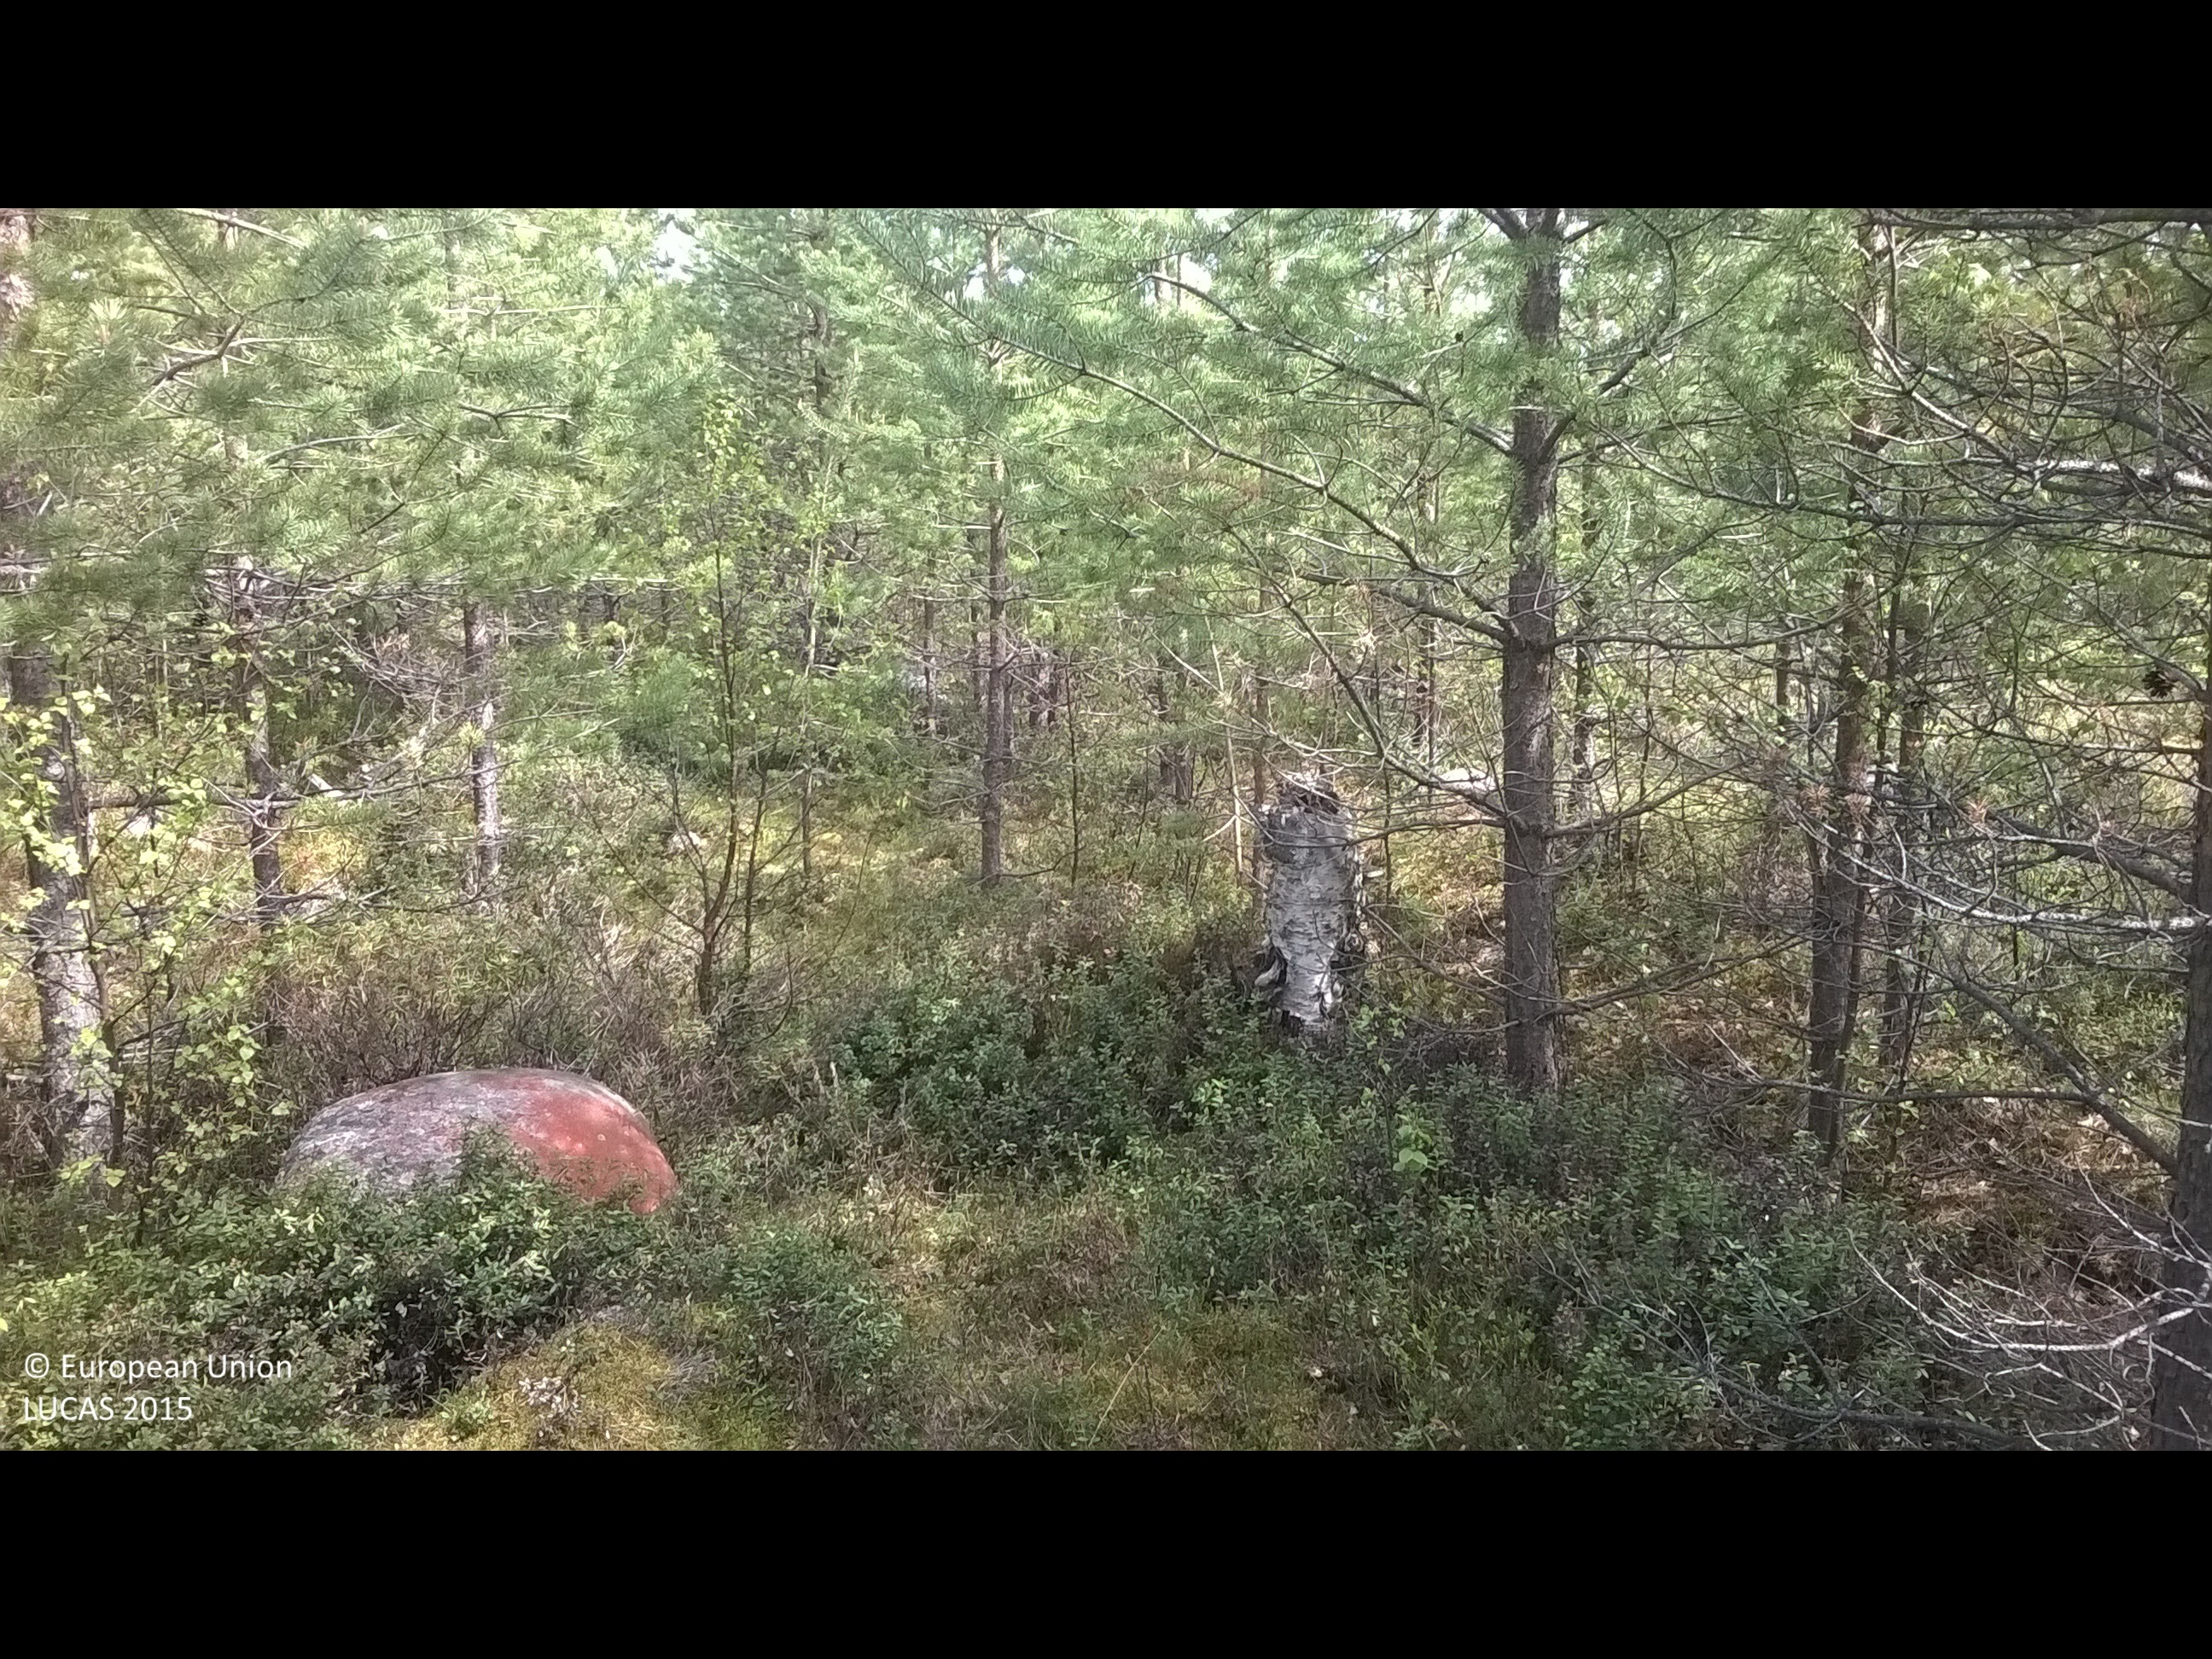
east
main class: Woodland
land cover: Pine dominated coniferous woodland
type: boreal forest
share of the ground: > 75 %
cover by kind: coniferous forest trees 90 %, broadleaved forest trees 5 %, shrubs 5 %
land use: Forestry
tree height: < 5 m
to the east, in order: Pine dominated coniferous woodland; Ditches and canals; Pine dominated coniferous woodland; Ditches and canals; Pine dominated coniferous woodland; Tracks; Pine dominated coniferous woodland; Ditches and canals; Pine dominated coniferous woodland; Ditches and canals; Pine dominated coniferous woodland; Pine dominated mixed woodland; Ditches and canals; Pine dominated mixed woodland; Ditches and canals; Pine dominated mixed woodland; Tracks; Pine dominated mixed woodland; Ditches and canals; Pine dominated mixed woodland; Ditches and canals; Pine dominated mixed woodland
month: June
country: FI
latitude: 66.5653
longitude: 26.5591
